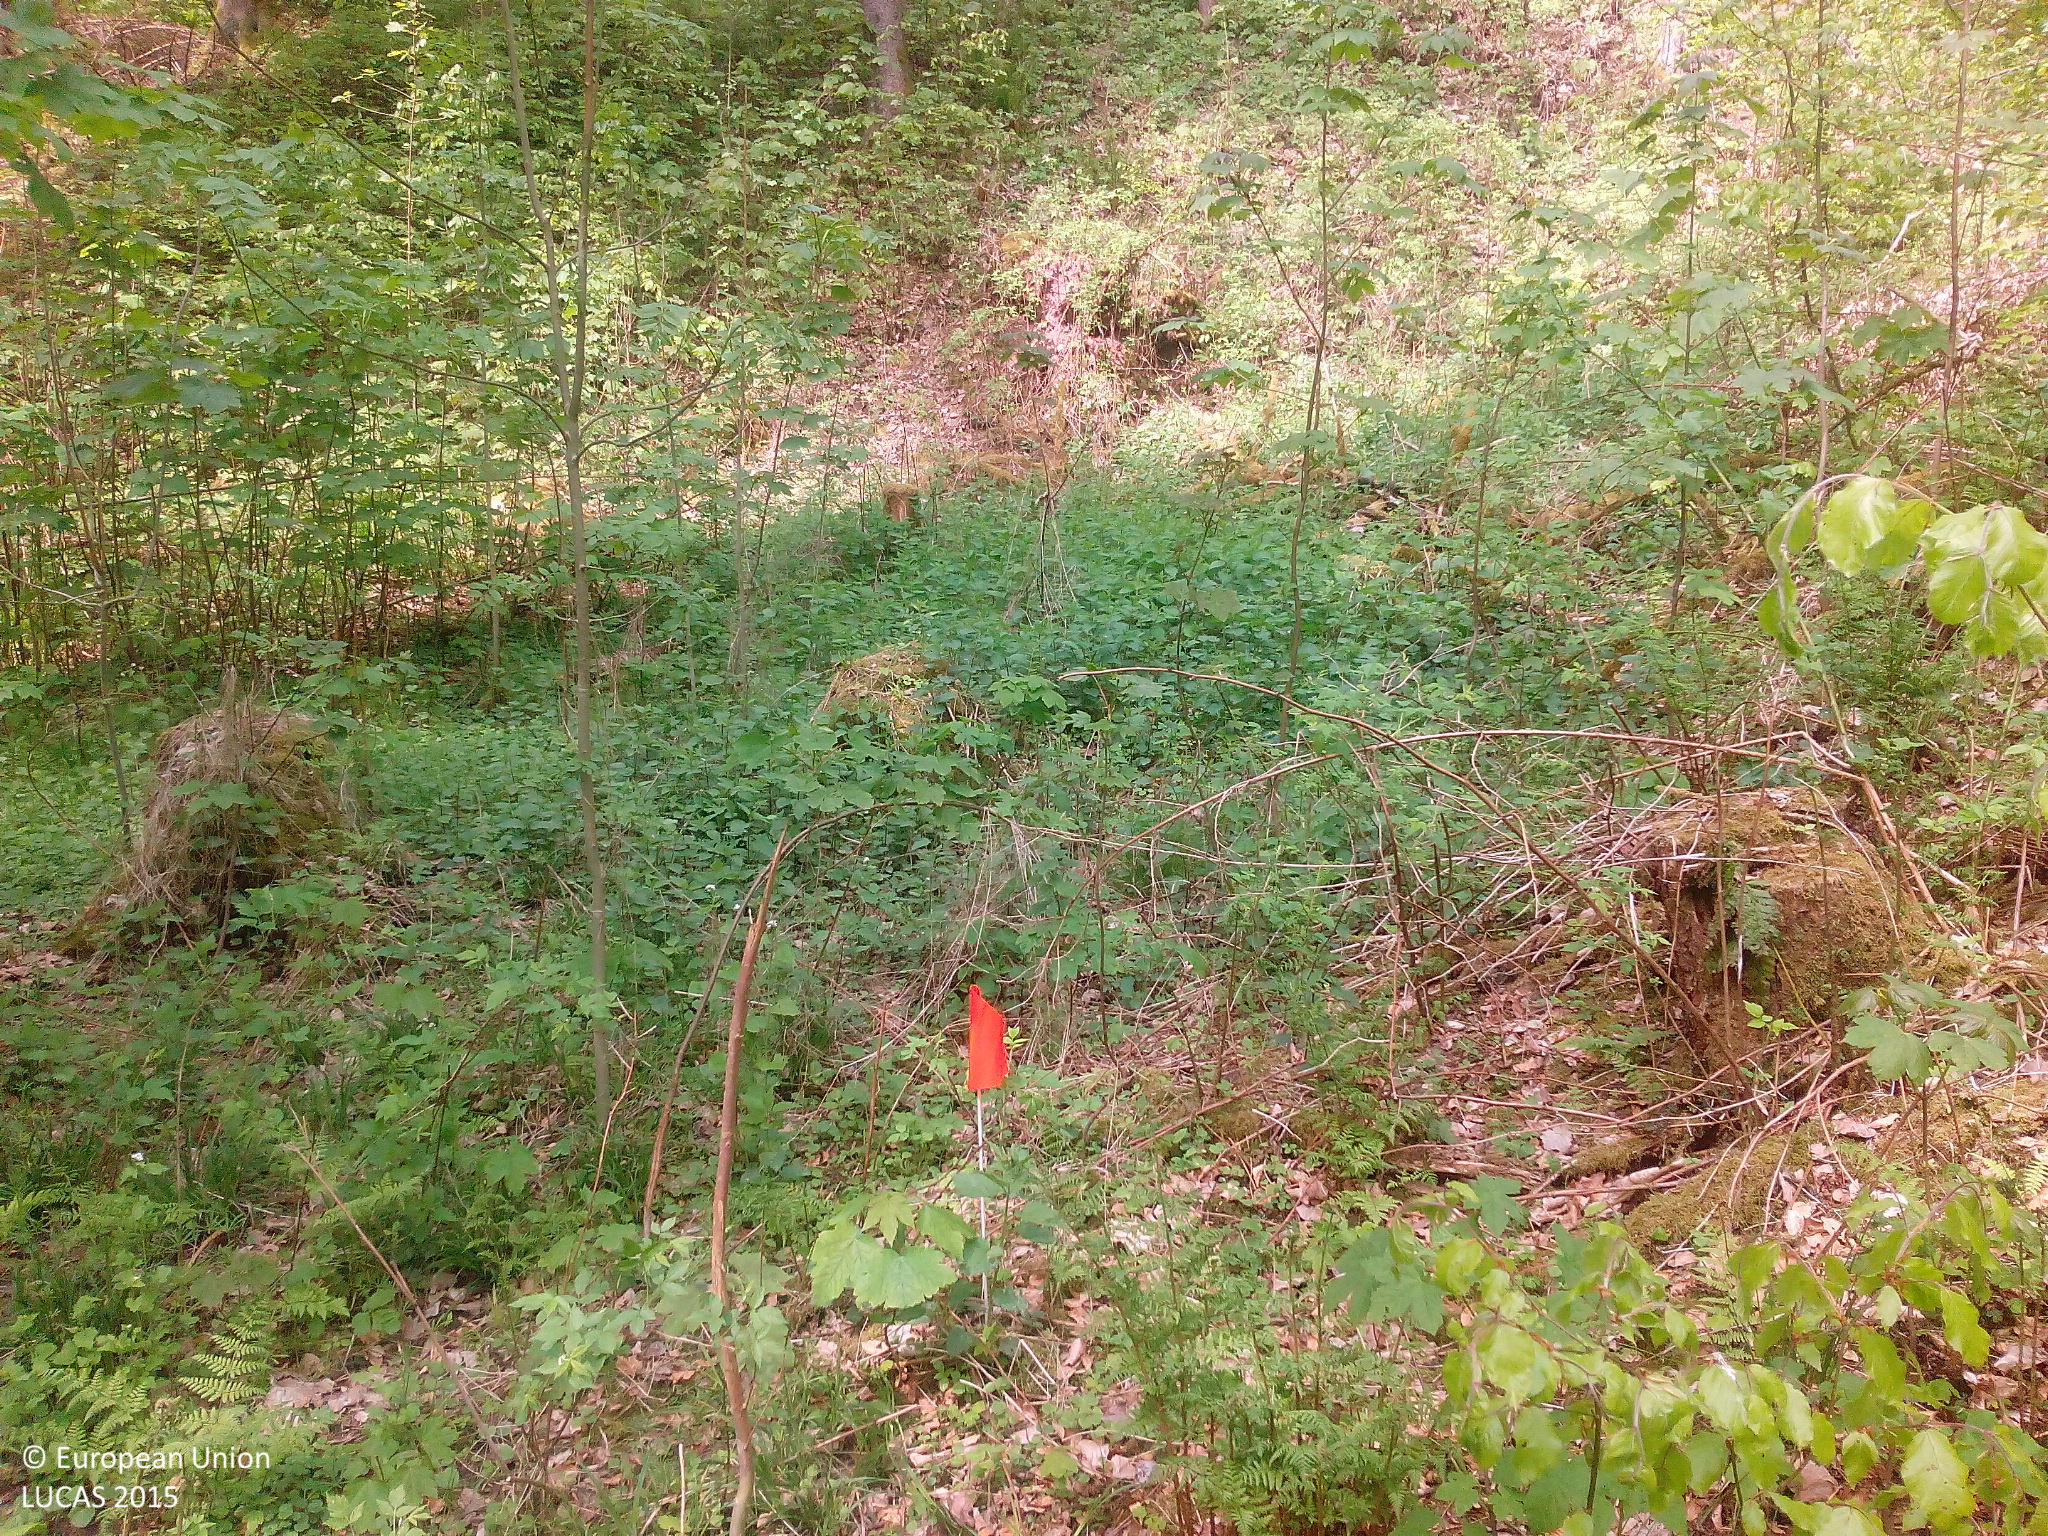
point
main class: Woodland
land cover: Broadleaved woodland
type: mesophytic deciduous forest
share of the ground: > 75 %
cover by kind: broadleaved forest trees 90 %, shrubs 10 %
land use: Forestry
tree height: > 5 m
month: May
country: DE
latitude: 50.3235
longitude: 11.0251
